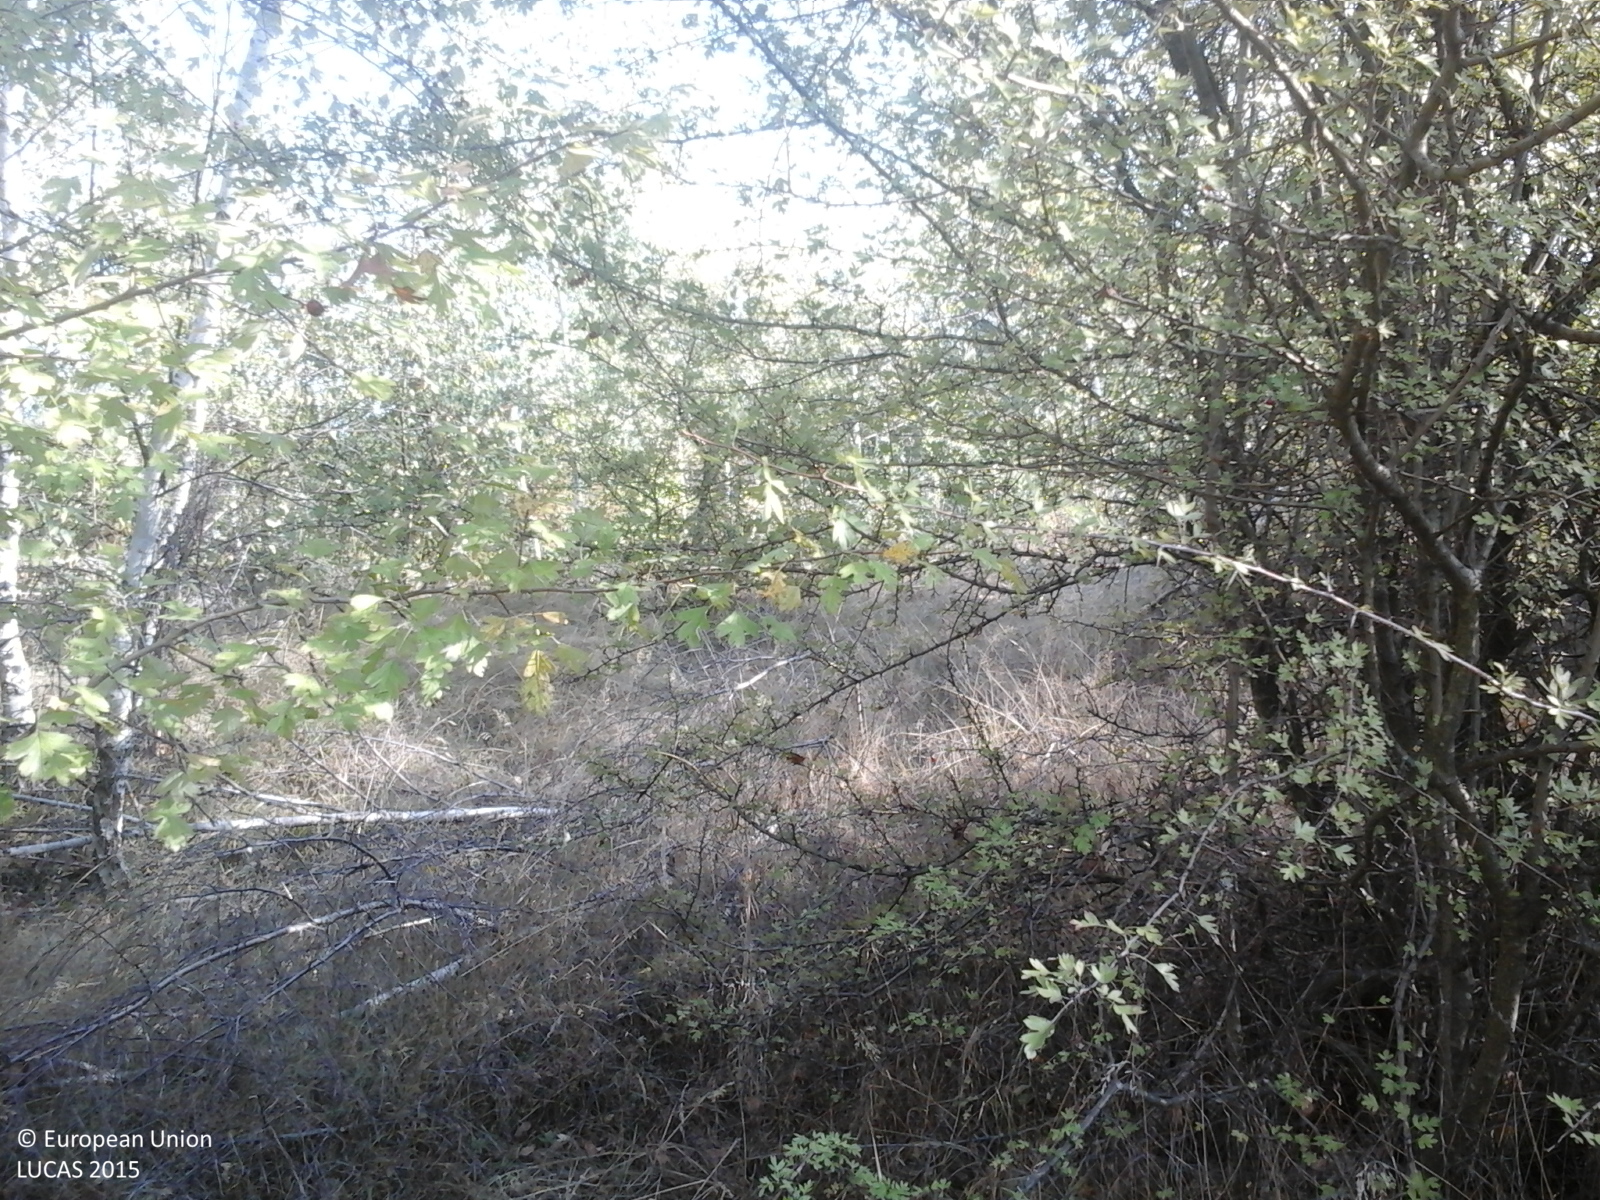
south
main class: Woodland
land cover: Broadleaved woodland
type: non-riverine alder, birch or aspen forest
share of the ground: > 75 %
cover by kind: broadleaved forest trees 100 %
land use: Forestry
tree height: > 5 m
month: September
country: RO
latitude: 45.2810
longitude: 22.2404
